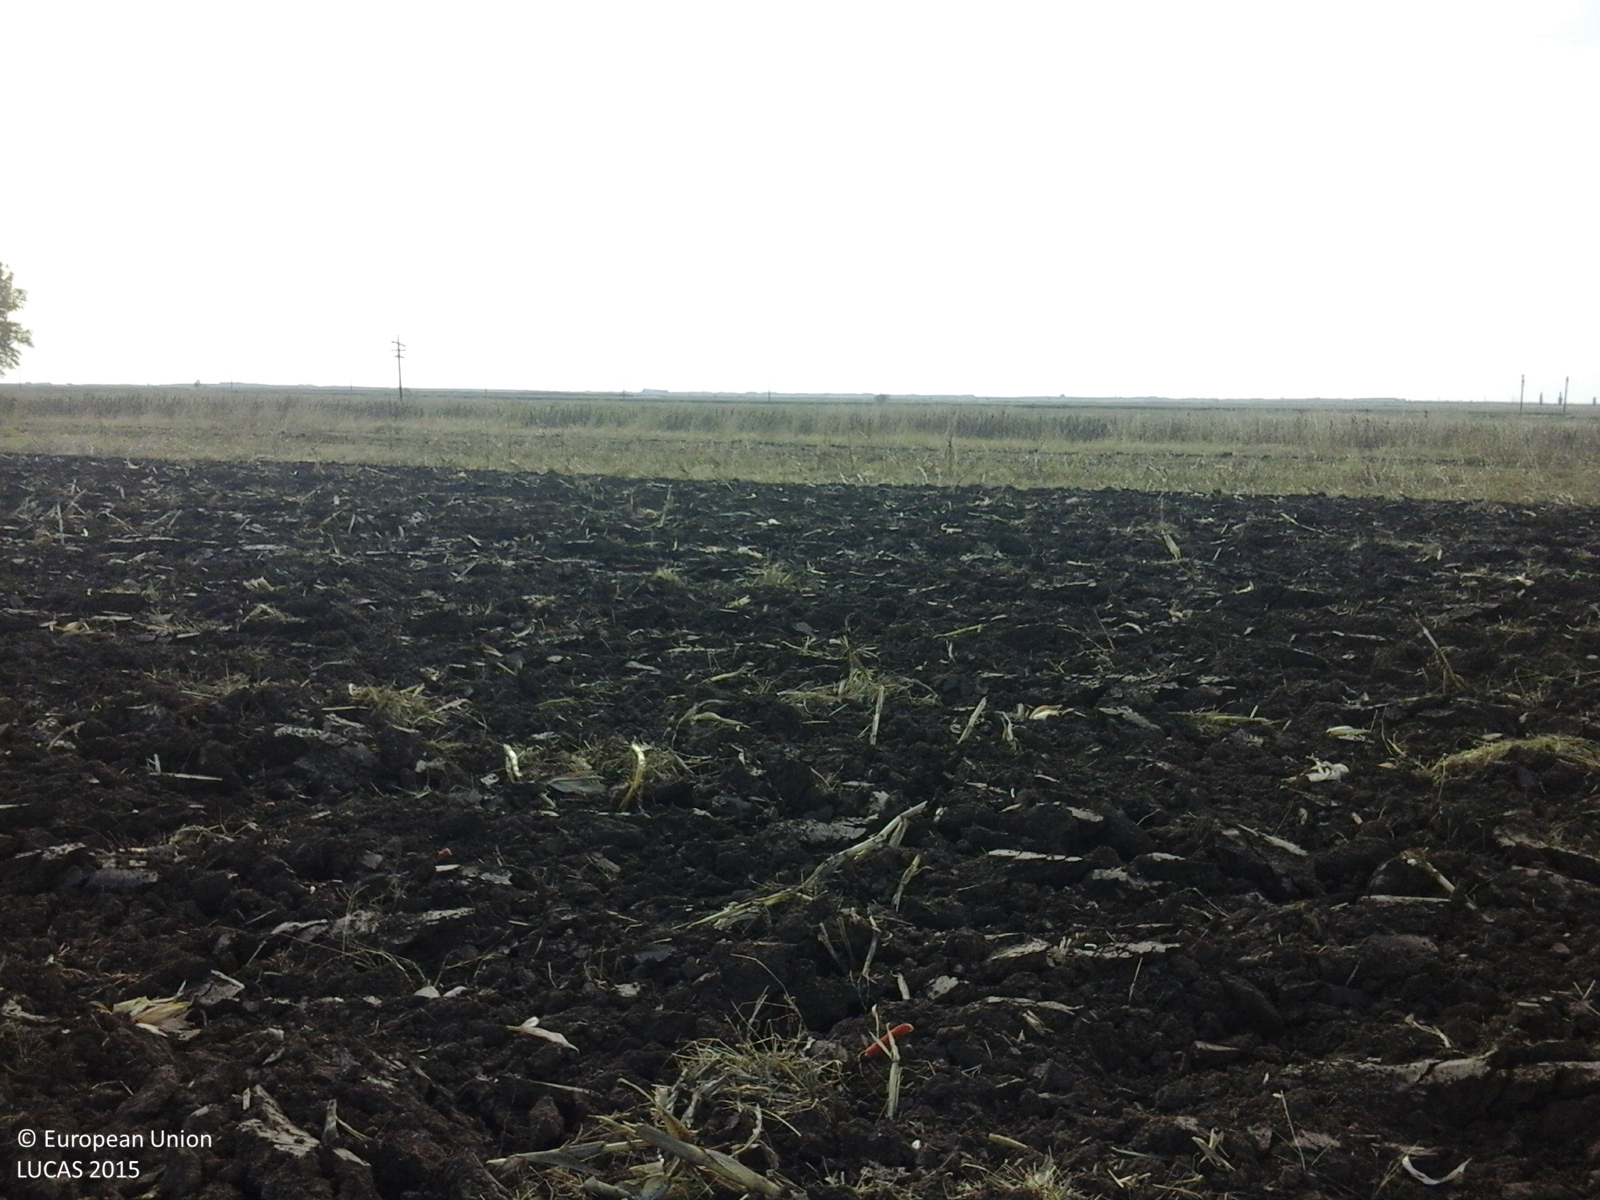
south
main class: Cropland
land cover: Maize
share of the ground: < 10 %
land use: Agriculture (excluding fallow land and kitchen gardens)
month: October
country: RO
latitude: 45.1740
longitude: 27.2575
